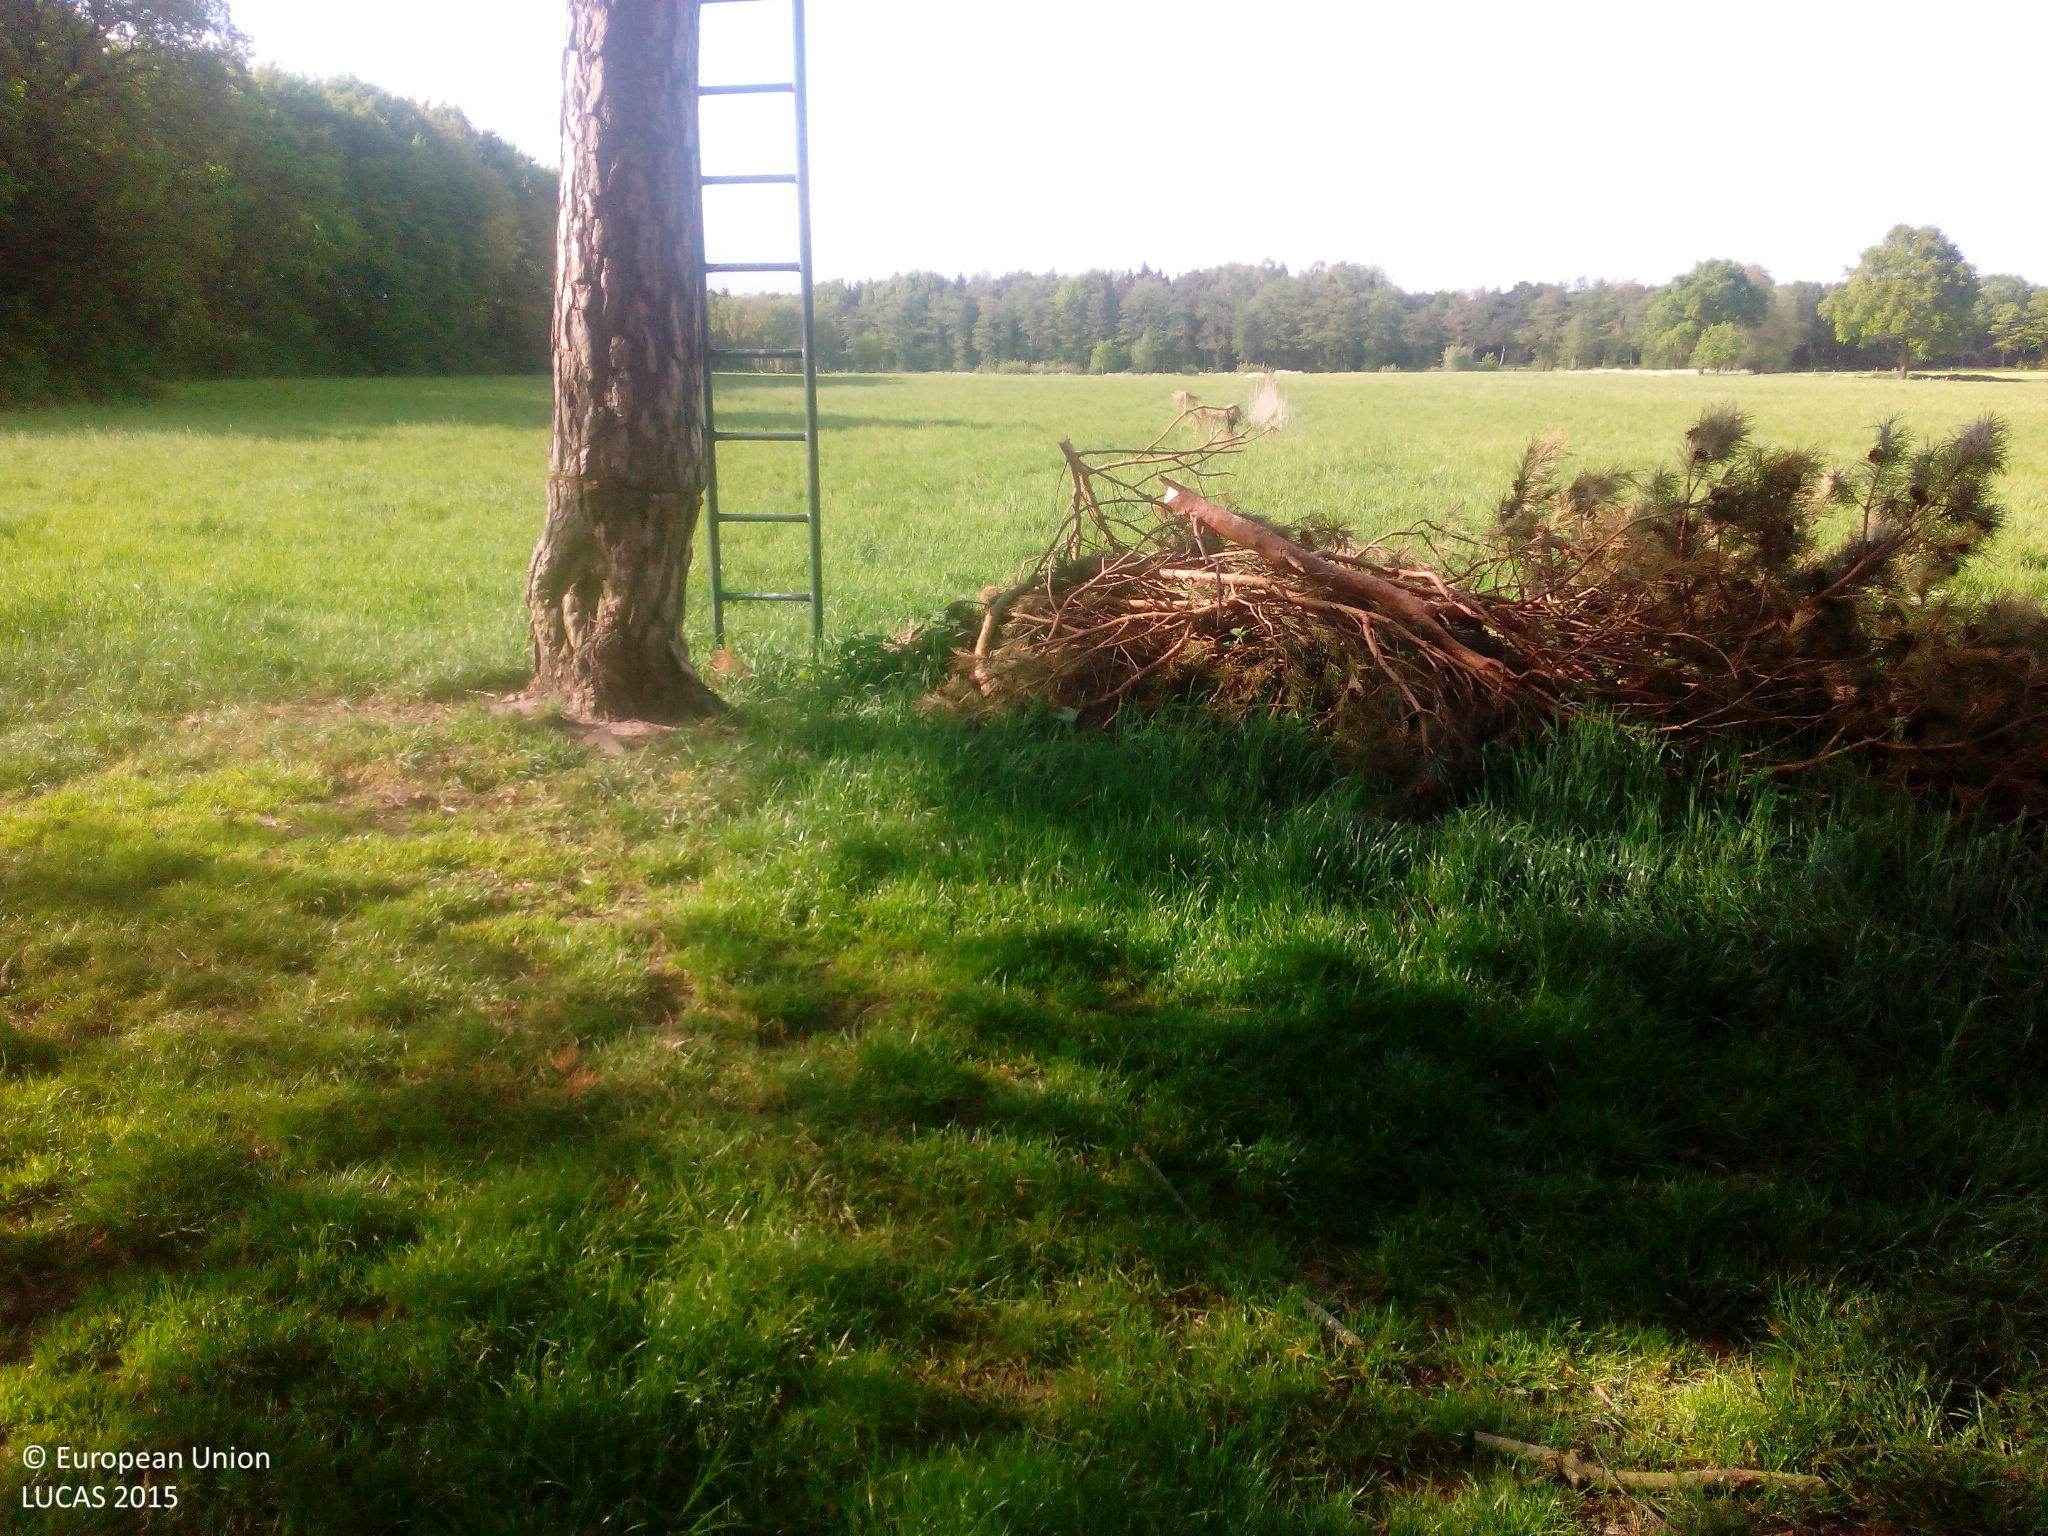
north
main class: Woodland
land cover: Pine dominated mixed woodland
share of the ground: 25 - 50 %
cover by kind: coniferous forest trees 35 %, unconsolidated bare surface 30 %, herbaceous plants 20 %, broadleaved forest trees 15 %
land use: Agriculture (excluding fallow land and kitchen gardens)
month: May
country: NL
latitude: 51.4671
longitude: 5.5790
